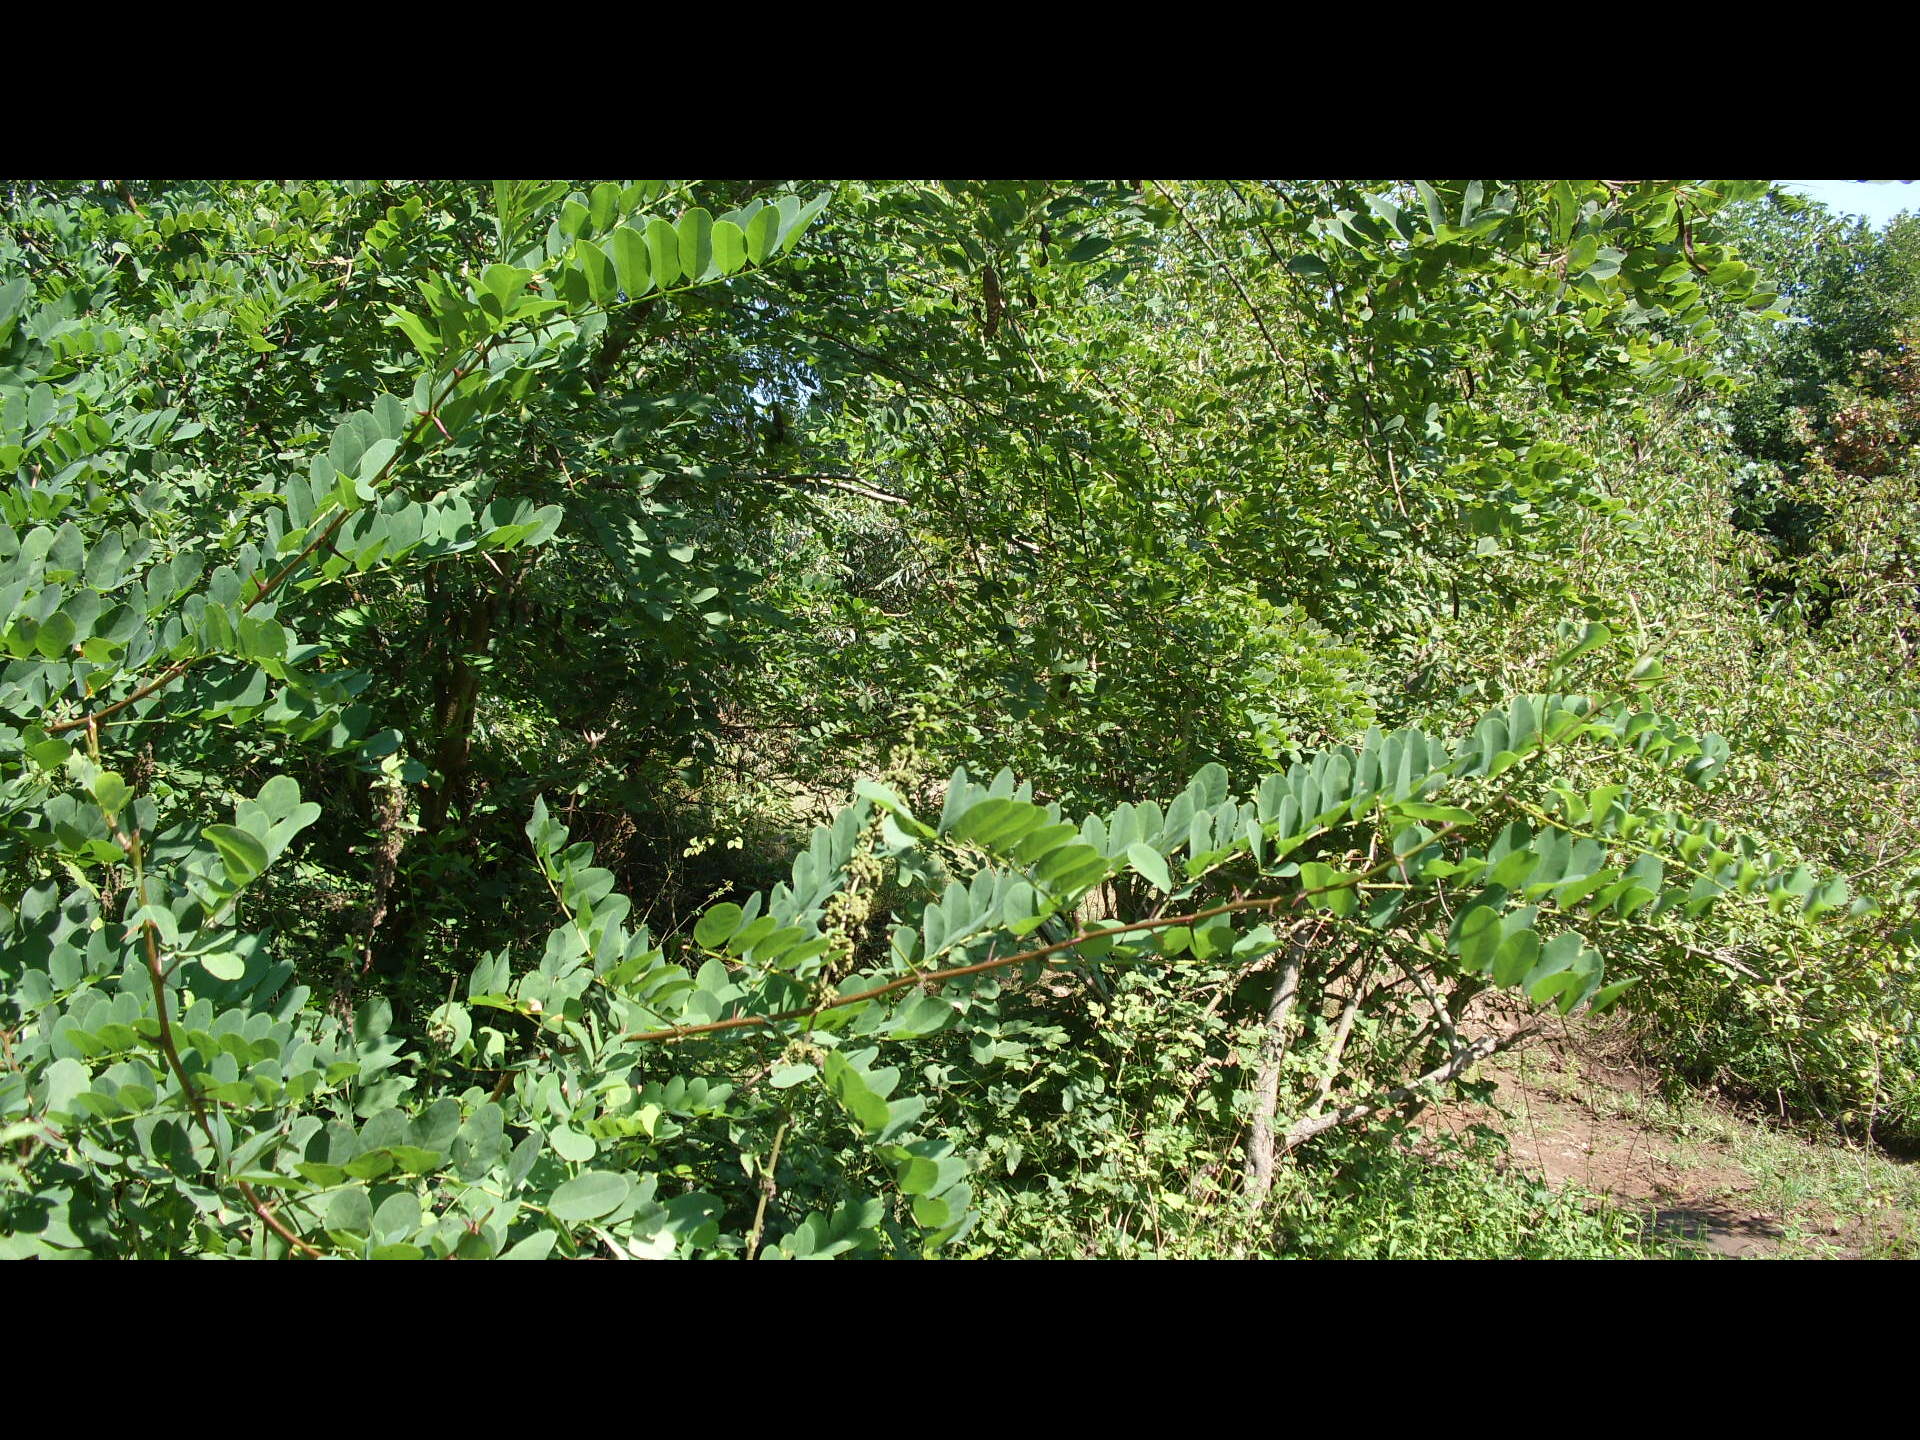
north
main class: Woodland
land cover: Broadleaved woodland
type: thermophilous deciduous forest
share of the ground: 50 - 75 %
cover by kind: broadleaved forest trees 60 %, shrubs 20 %, herbaceous plants 20 %
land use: Forestry
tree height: < 5 m
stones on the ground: < 10 %
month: August
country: BG
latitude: 43.4912
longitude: 23.0088
